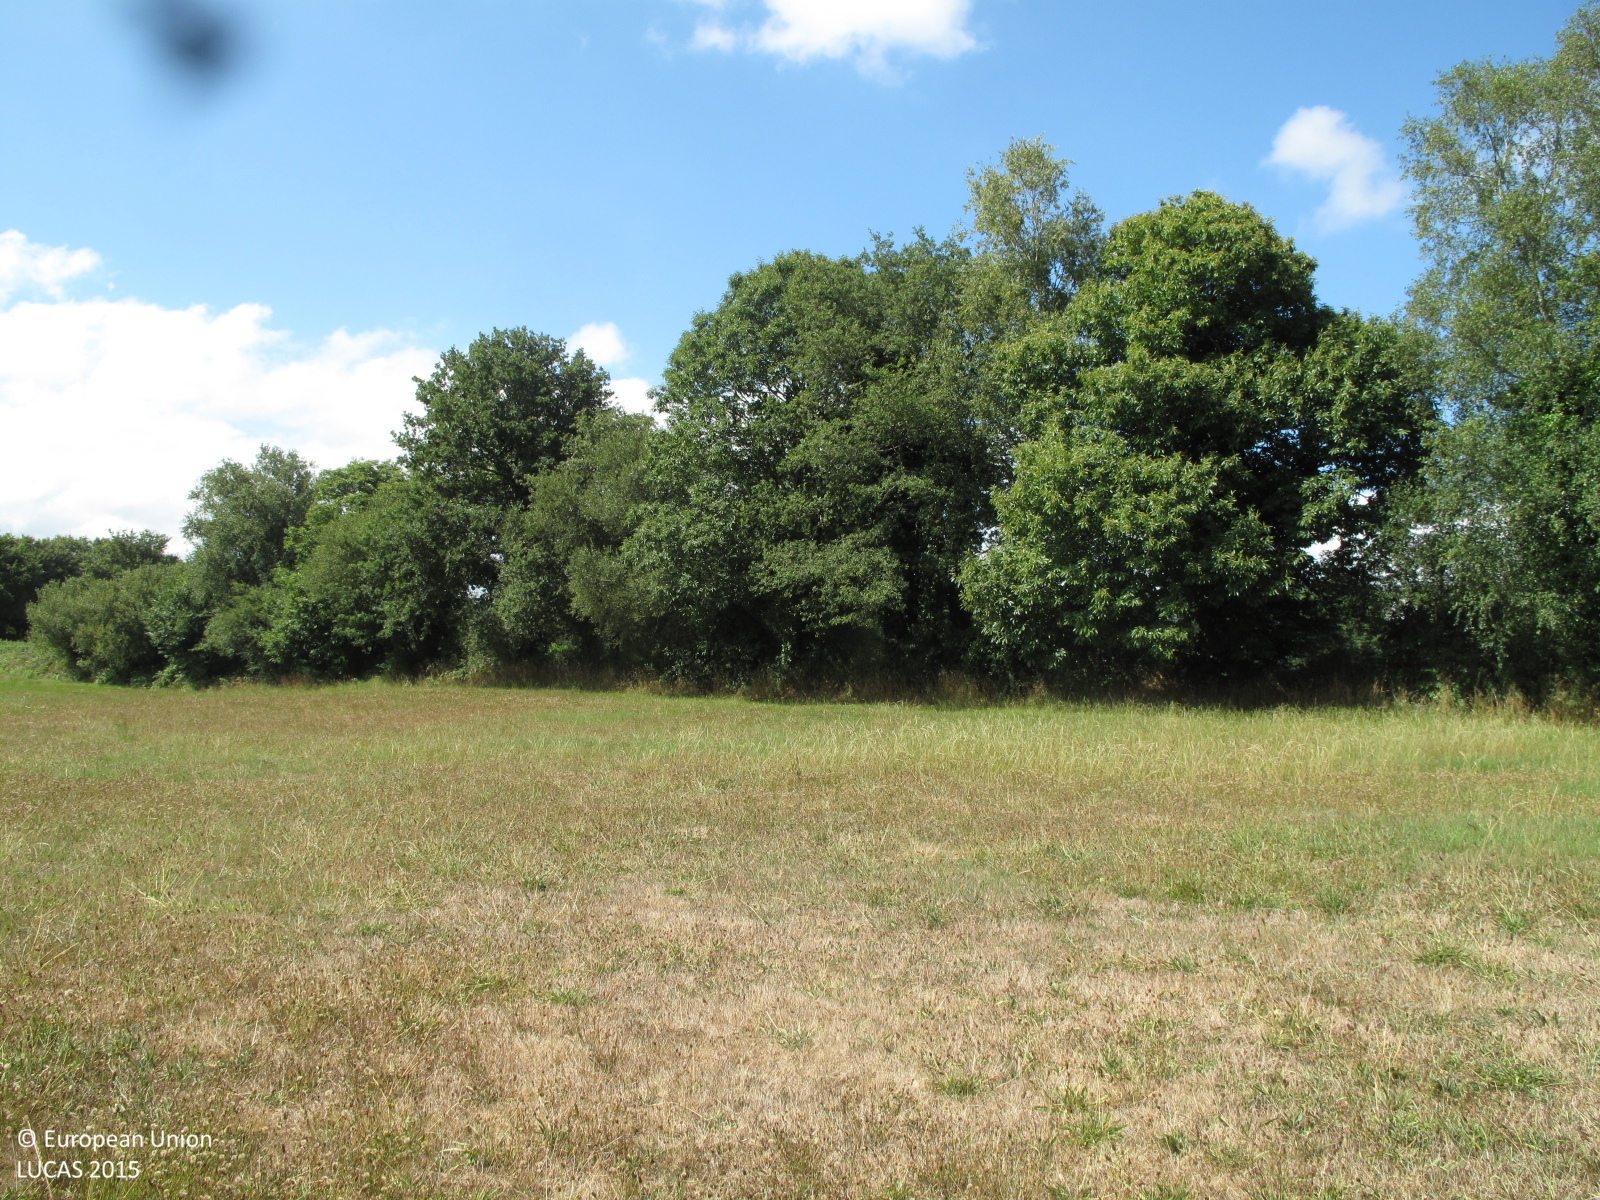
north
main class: Grassland
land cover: Grassland without tree/shrub cover
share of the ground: > 75 %
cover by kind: herbaceous plants 100 %
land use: Agriculture (excluding fallow land and kitchen gardens)
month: July
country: ES
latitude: 43.0987
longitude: -8.0681
